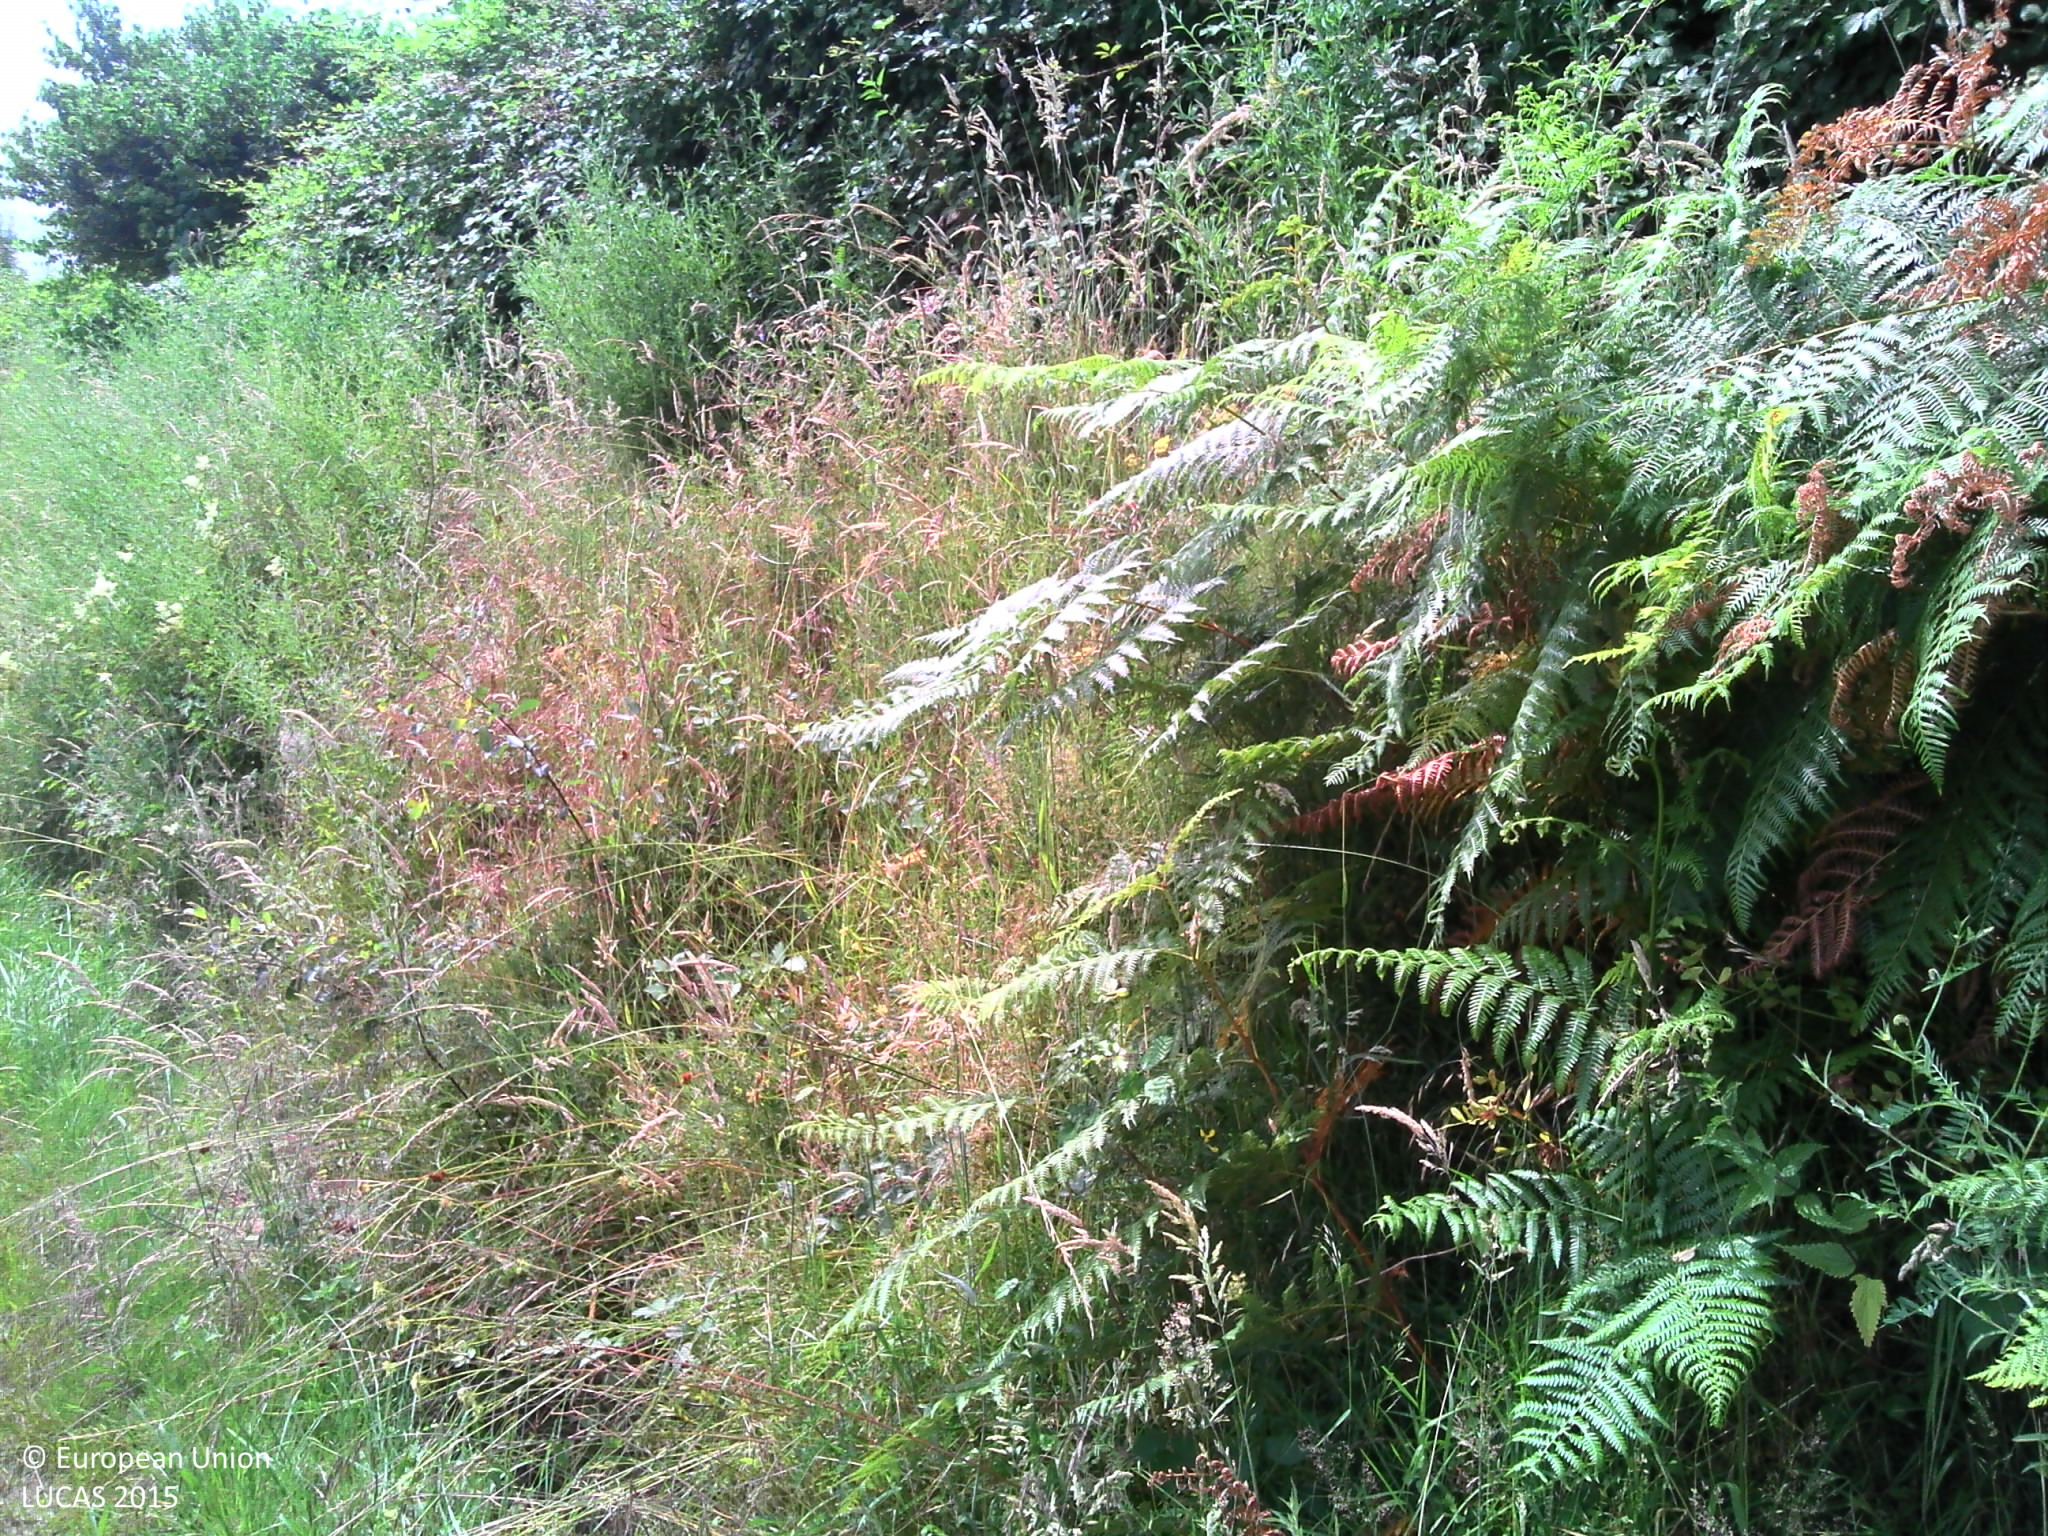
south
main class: Shrubland
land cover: Shrubland with sparse tree cover
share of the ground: > 75 %
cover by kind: shrubs 90 %, broadleaved forest trees 5 %, herbaceous plants 5 %
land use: Semi-natural and natural areas not in use
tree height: > 5 m
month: July
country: FR
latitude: 43.6082
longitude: -0.7540
